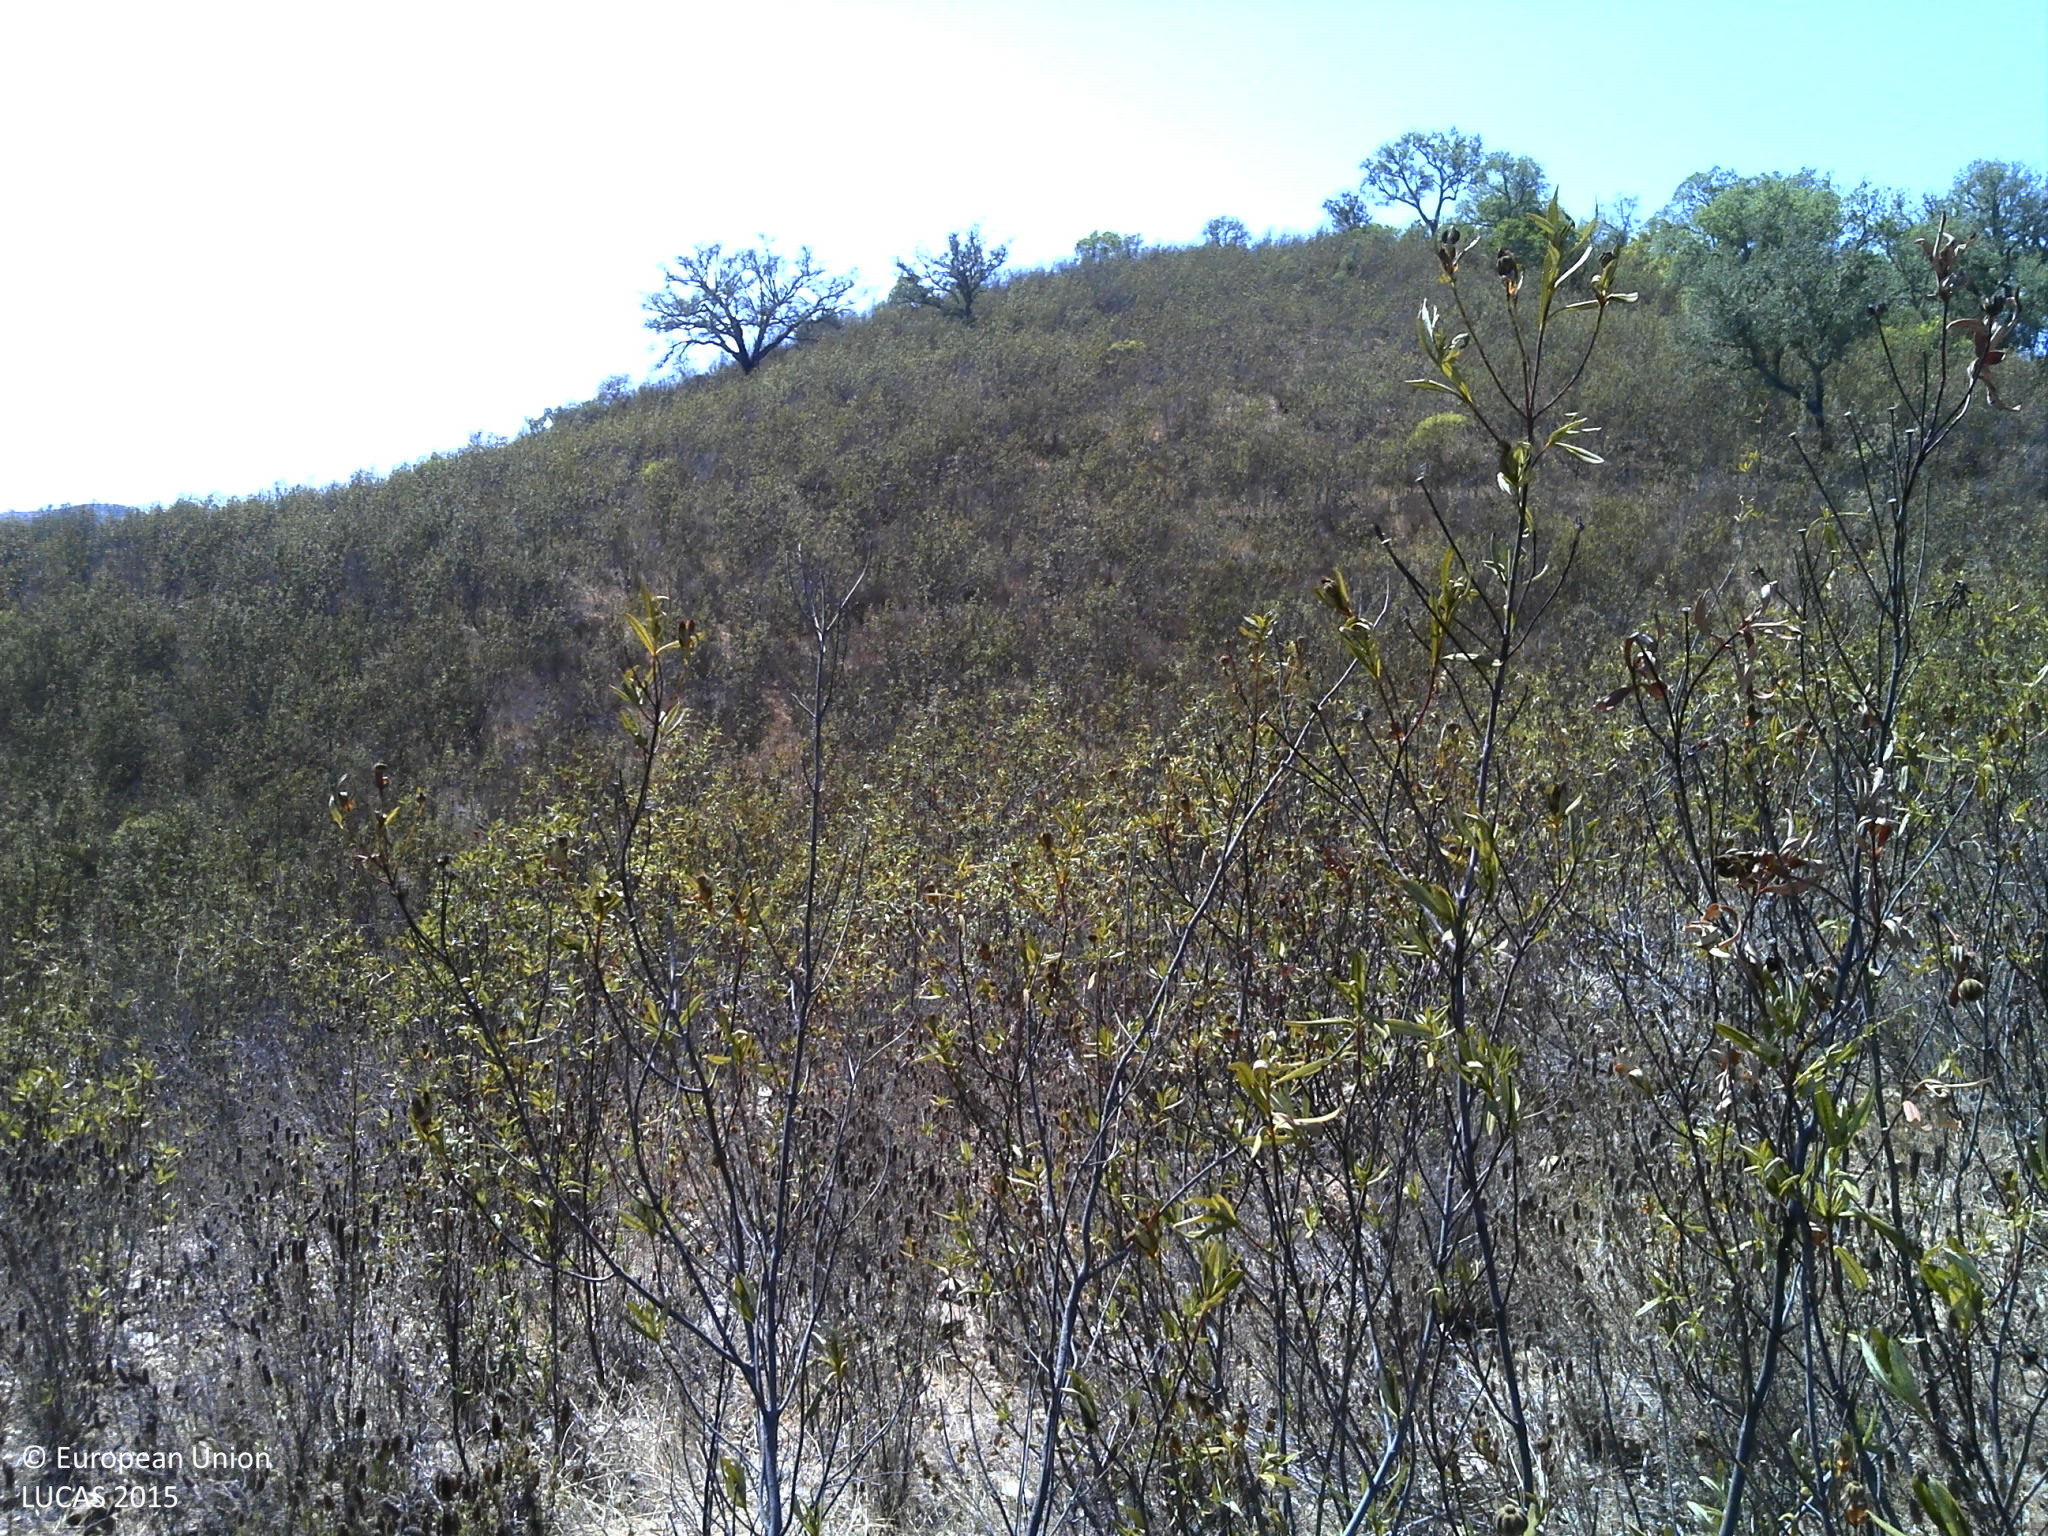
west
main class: Shrubland
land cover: Shrubland without tree cover
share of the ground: 50 - 75 %
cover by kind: shrubs 75 %, unconsolidated bare surface 20 %, herbaceous plants 5 %
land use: Forestry
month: September
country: PT
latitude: 37.4676
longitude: -8.2404
